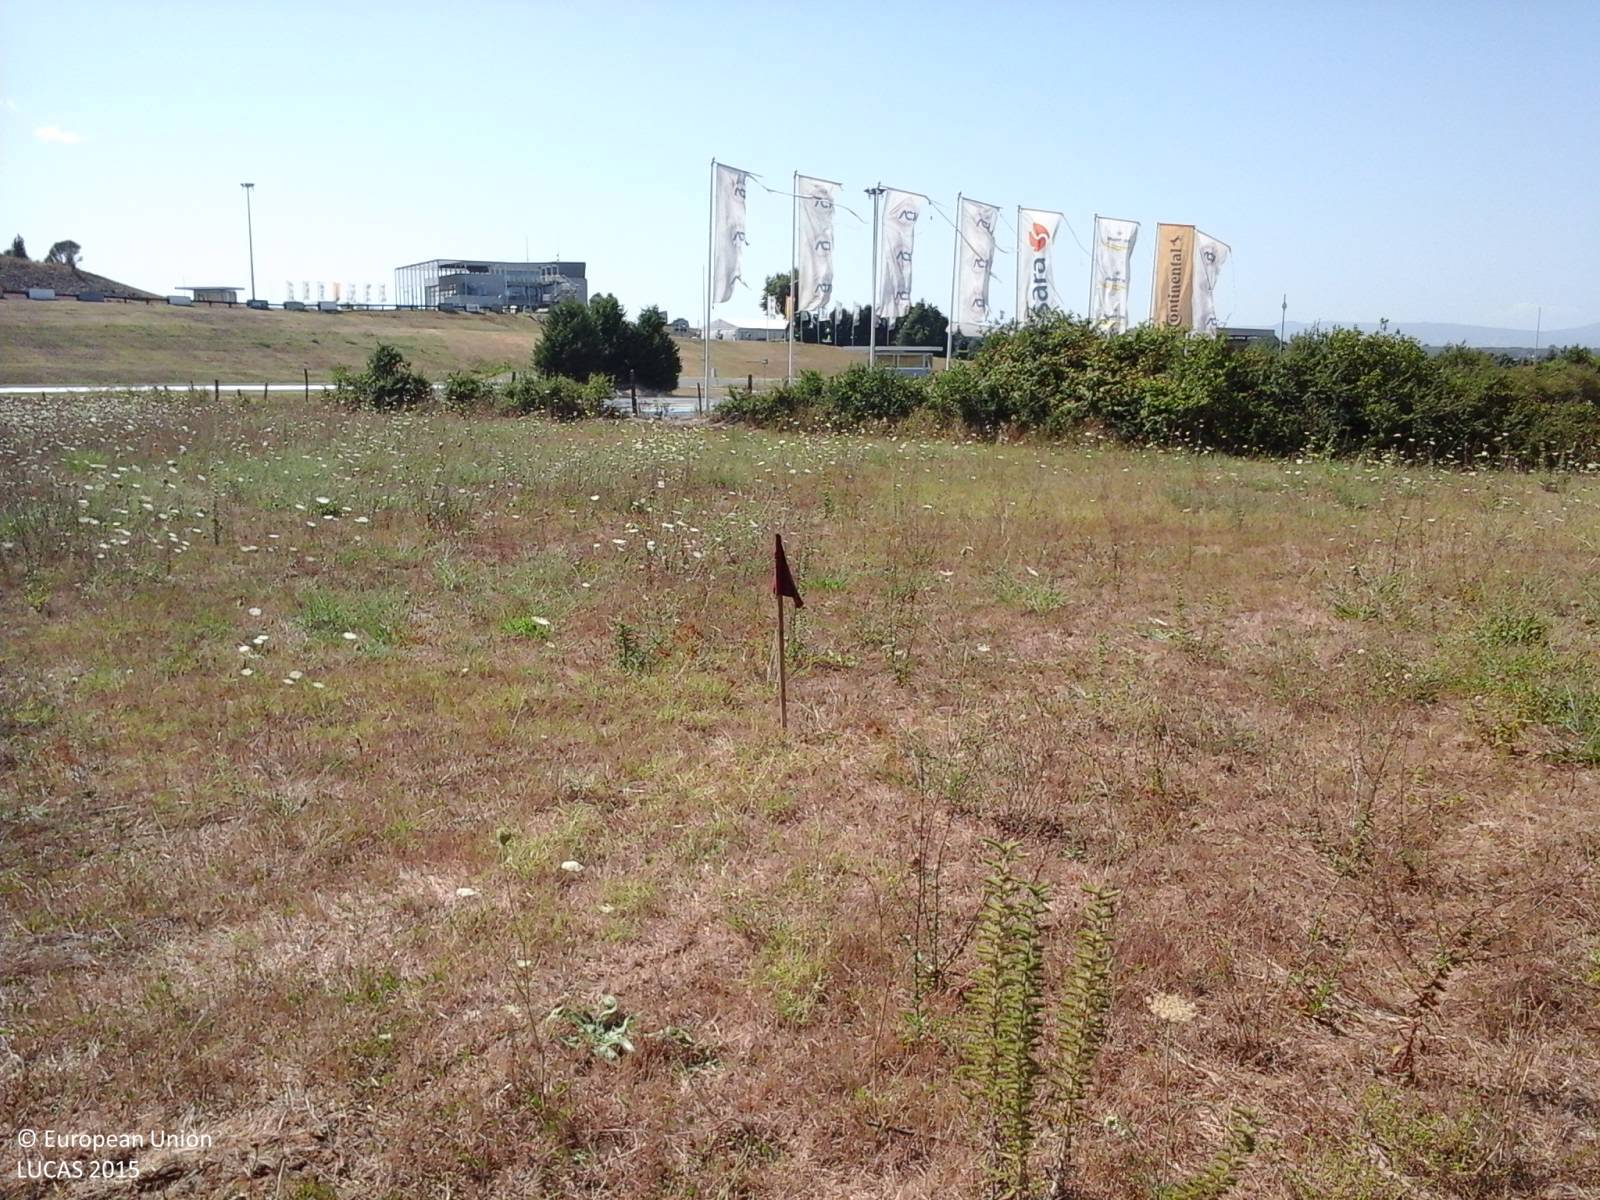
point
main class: Grassland
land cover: Grassland without tree/shrub cover
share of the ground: > 75 %
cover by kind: herbaceous plants 100 %
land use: Agriculture (excluding fallow land and kitchen gardens)
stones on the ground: < 10 %
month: July
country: IT
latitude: 42.1563
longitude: 12.3757
